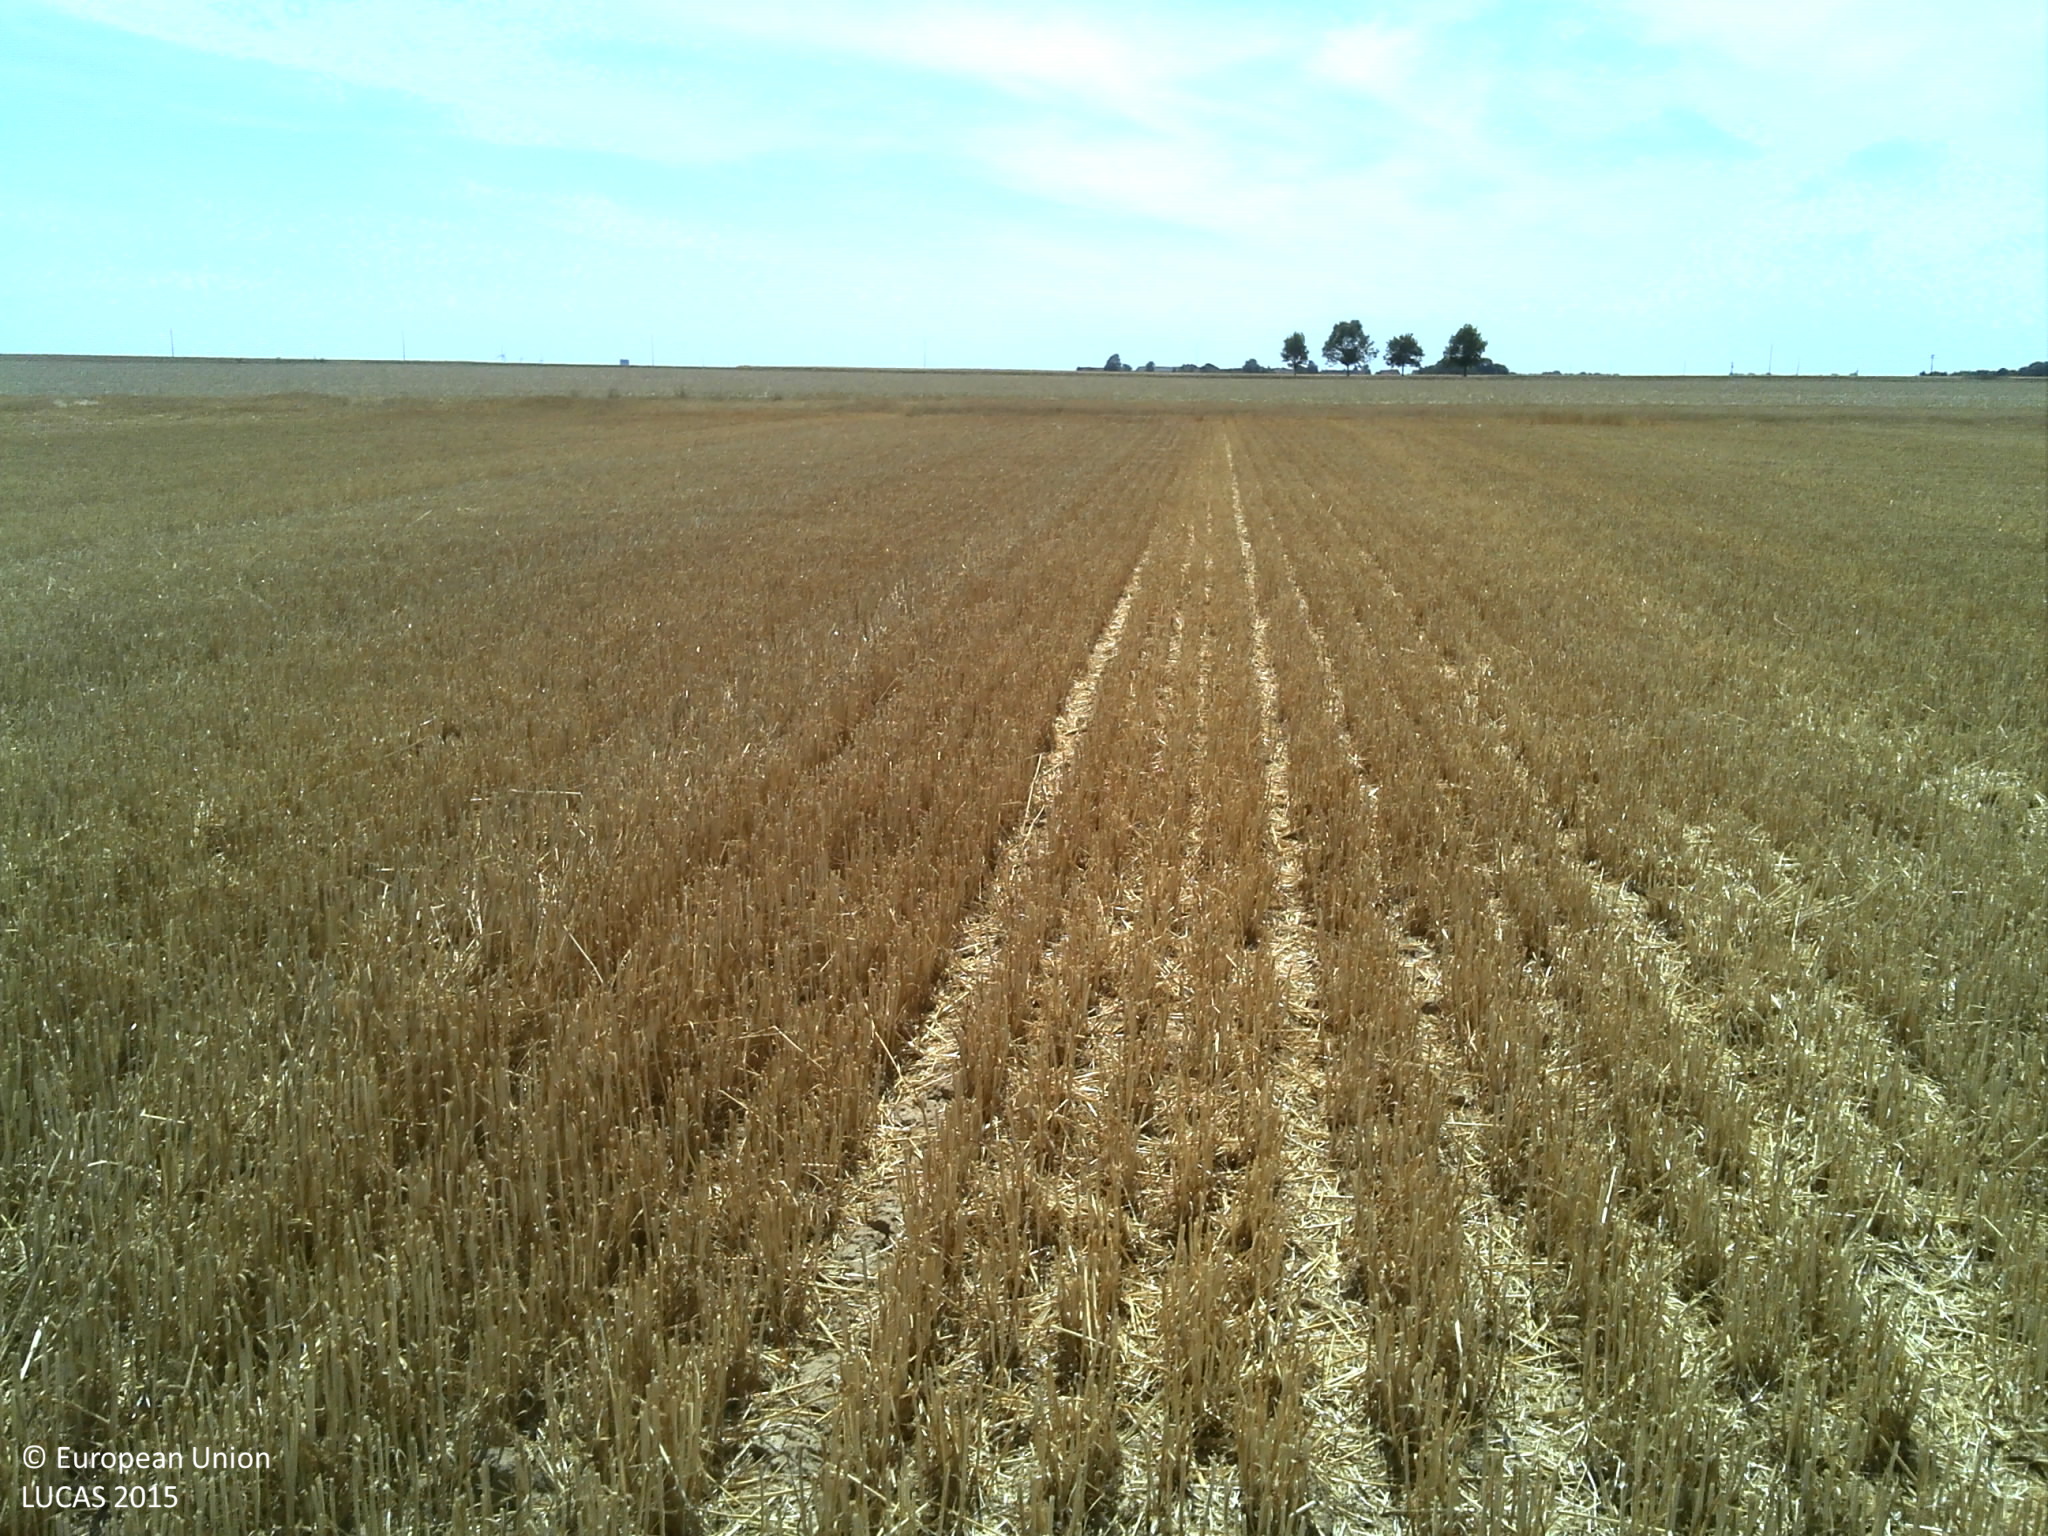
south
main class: Cropland
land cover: Common wheat
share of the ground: > 75 %
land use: Agriculture (excluding fallow land and kitchen gardens)
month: July
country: FR
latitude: 48.4665
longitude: 1.8845
